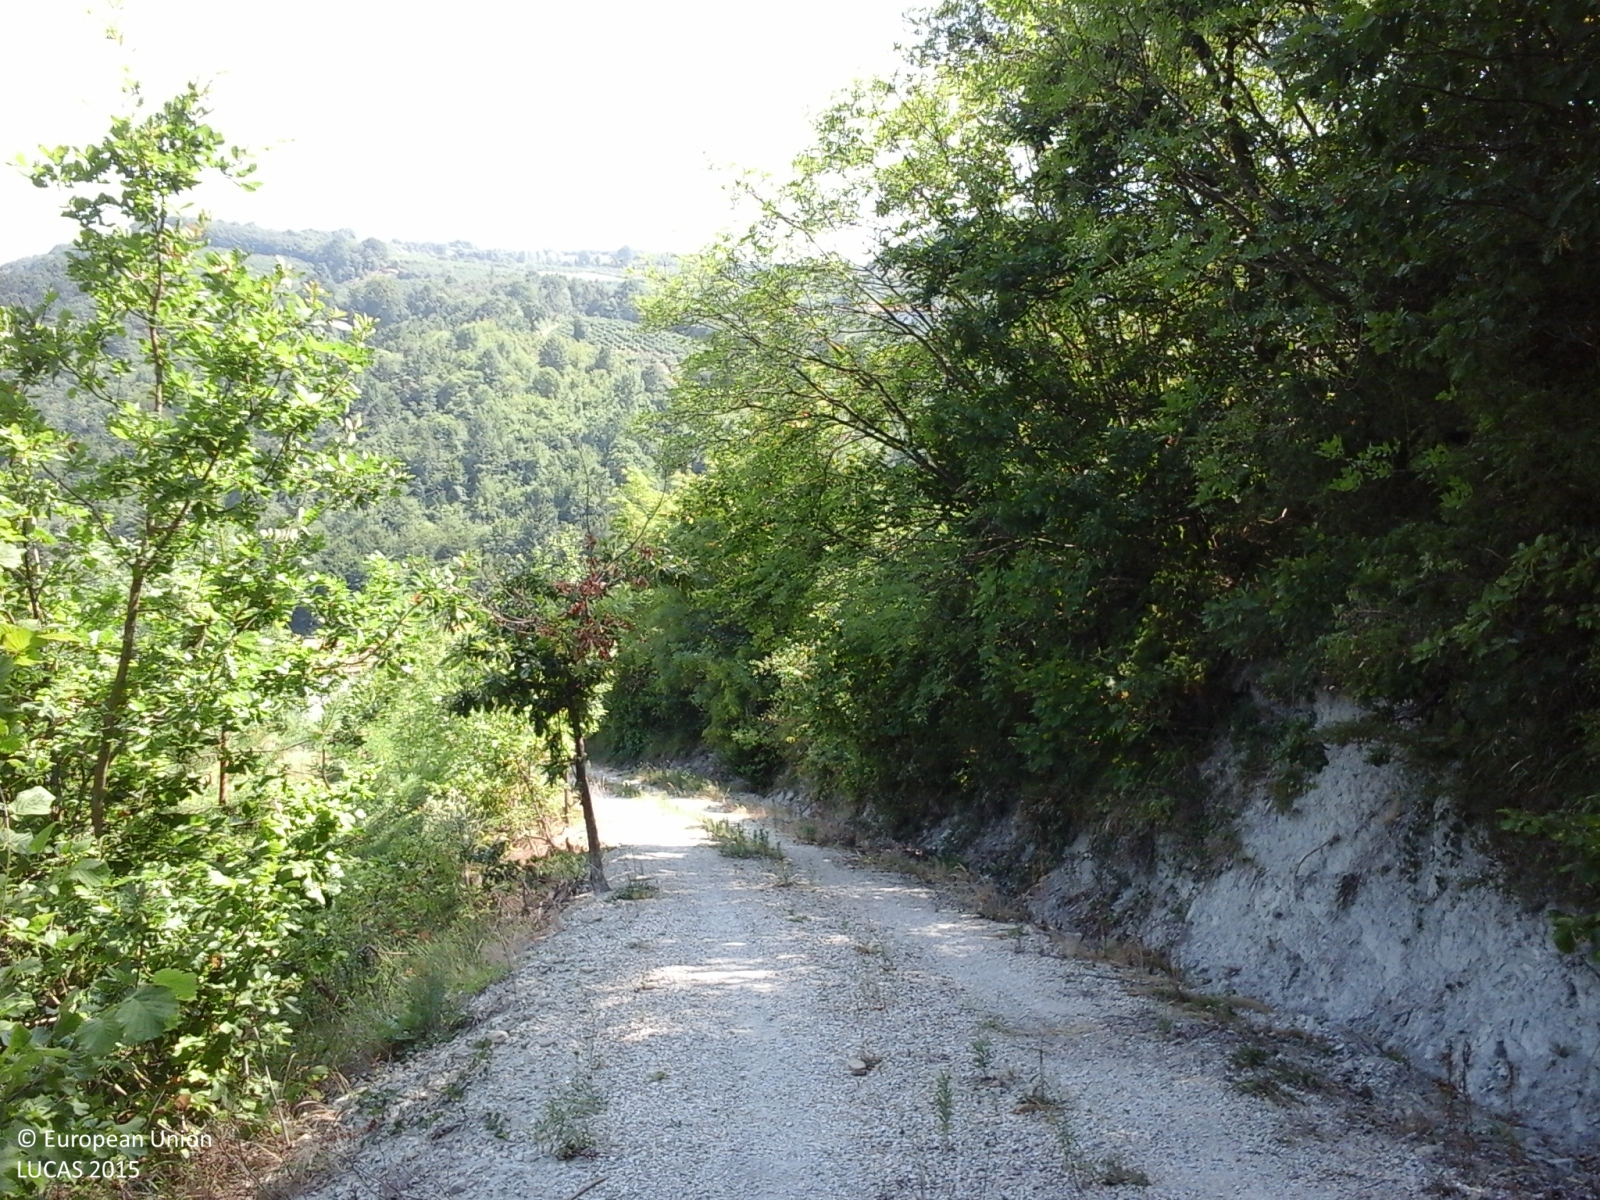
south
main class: Woodland
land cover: Broadleaved woodland
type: thermophilous deciduous forest
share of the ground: > 75 %
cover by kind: broadleaved forest trees 90 %, shrubs 10 %
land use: Forestry
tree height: > 5 m
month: July
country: IT
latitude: 44.6223
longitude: 8.1260
